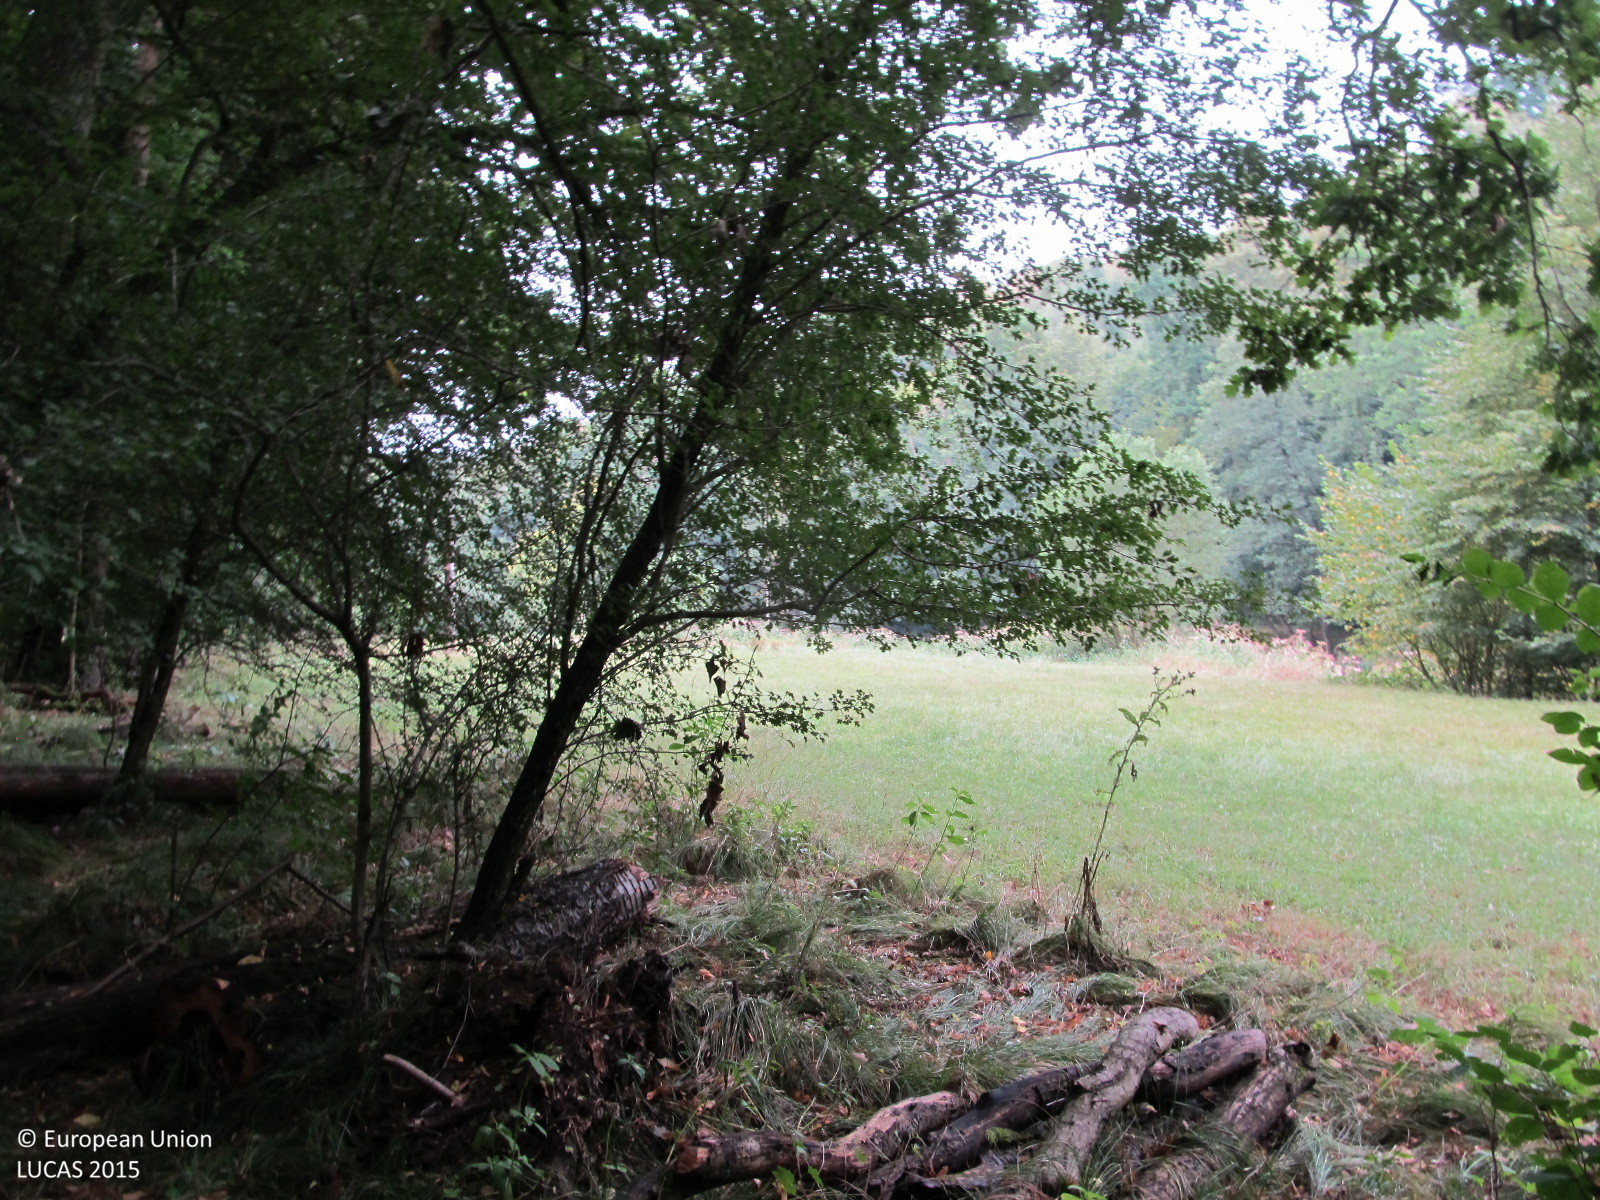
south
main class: Woodland
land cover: Other mixed woodland
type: hemiboreal forest and nemoral coniferous forest and mixed broadleaved-coniferous forest
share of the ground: > 75 %
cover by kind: broadleaved forest trees 50 %, coniferous forest trees 30 %, shrubs 10 %, herbaceous plants 10 %
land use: Forestry
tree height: > 5 m
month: August
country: AT
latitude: 48.8453
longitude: 15.4674
